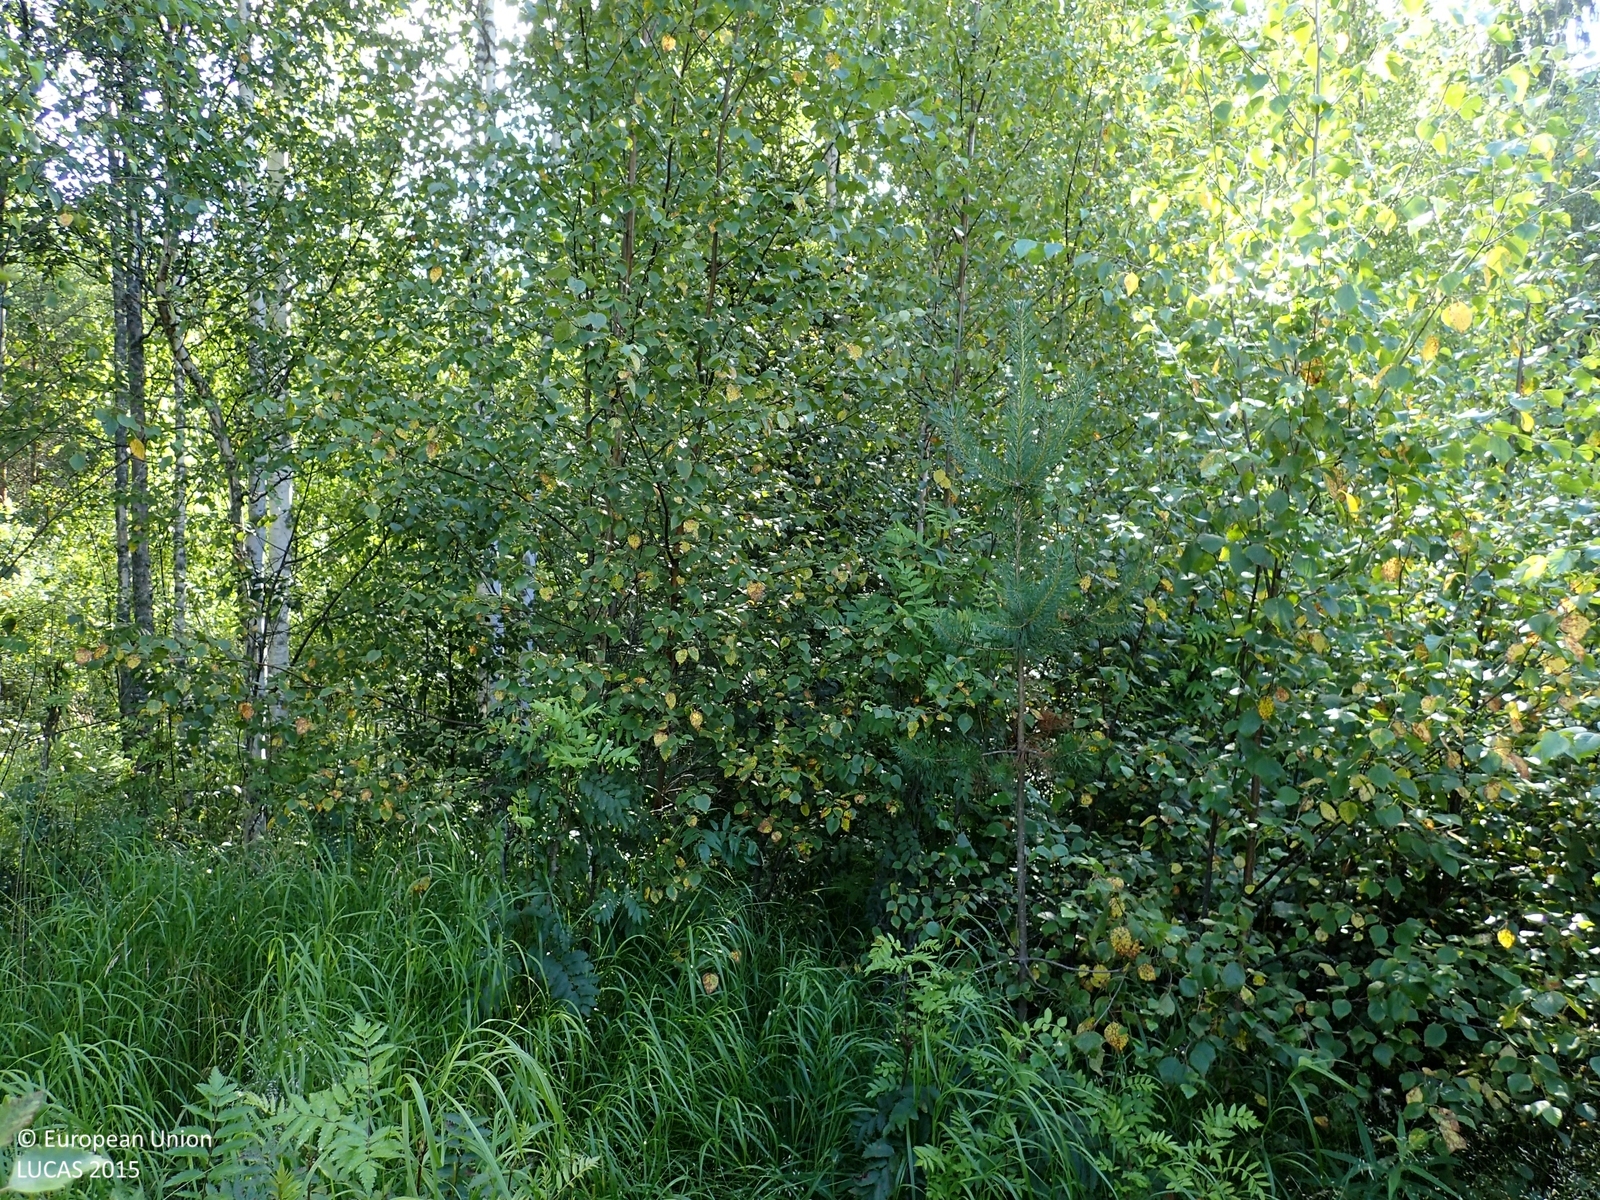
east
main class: Woodland
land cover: Broadleaved woodland
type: non-riverine alder, birch or aspen forest
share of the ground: > 75 %
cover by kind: broadleaved forest trees 90 %, herbaceous plants 10 %
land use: Forestry
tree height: < 5 m
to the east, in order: Broadleaved woodland; Ditches and canals; Broadleaved woodland; Ditches and canals; Spruce dominated mixed woodland; Pine dominated mixed woodland; Pine dominated coniferous woodland; Pine dominated mixed woodland
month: August
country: FI
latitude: 62.7159
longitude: 21.9949
